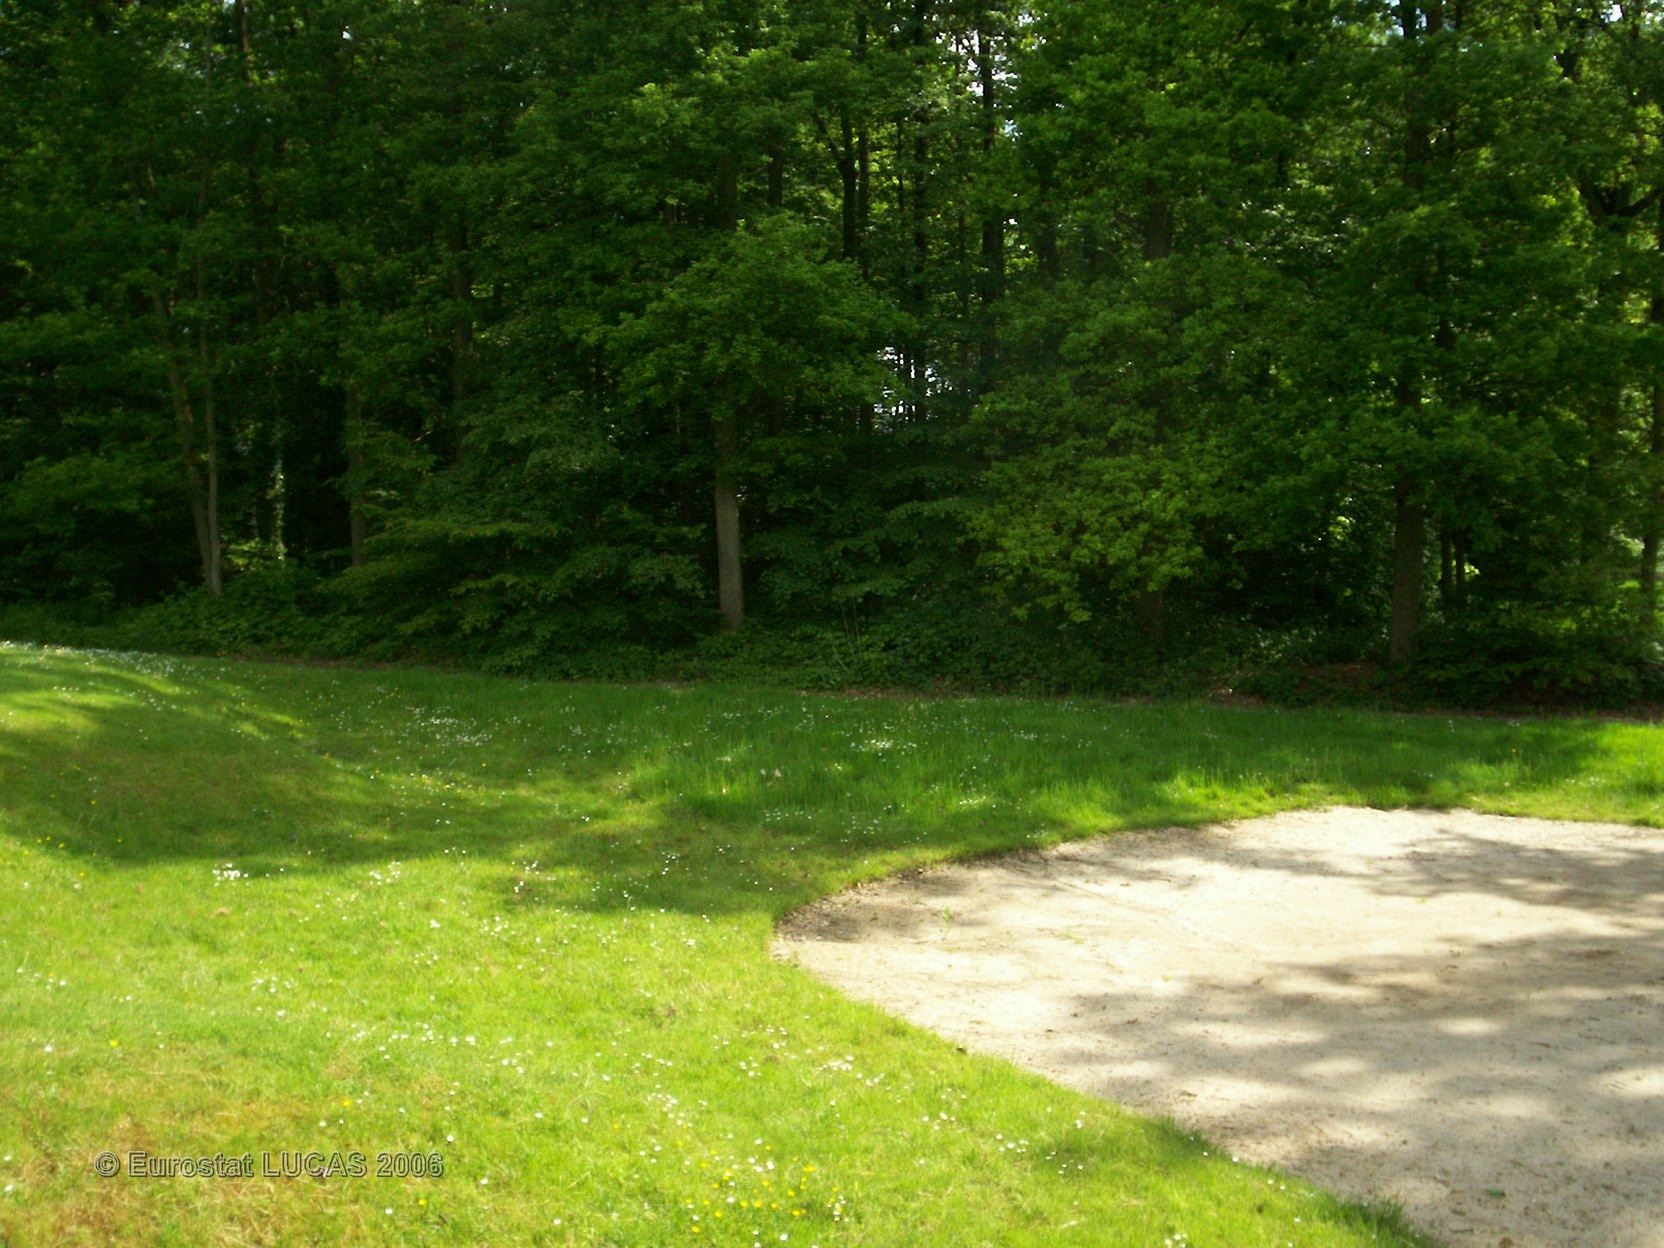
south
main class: Grassland
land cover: Grassland without tree/shrub cover
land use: Sport
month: May
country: FR
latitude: 48.7411
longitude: 2.7149
